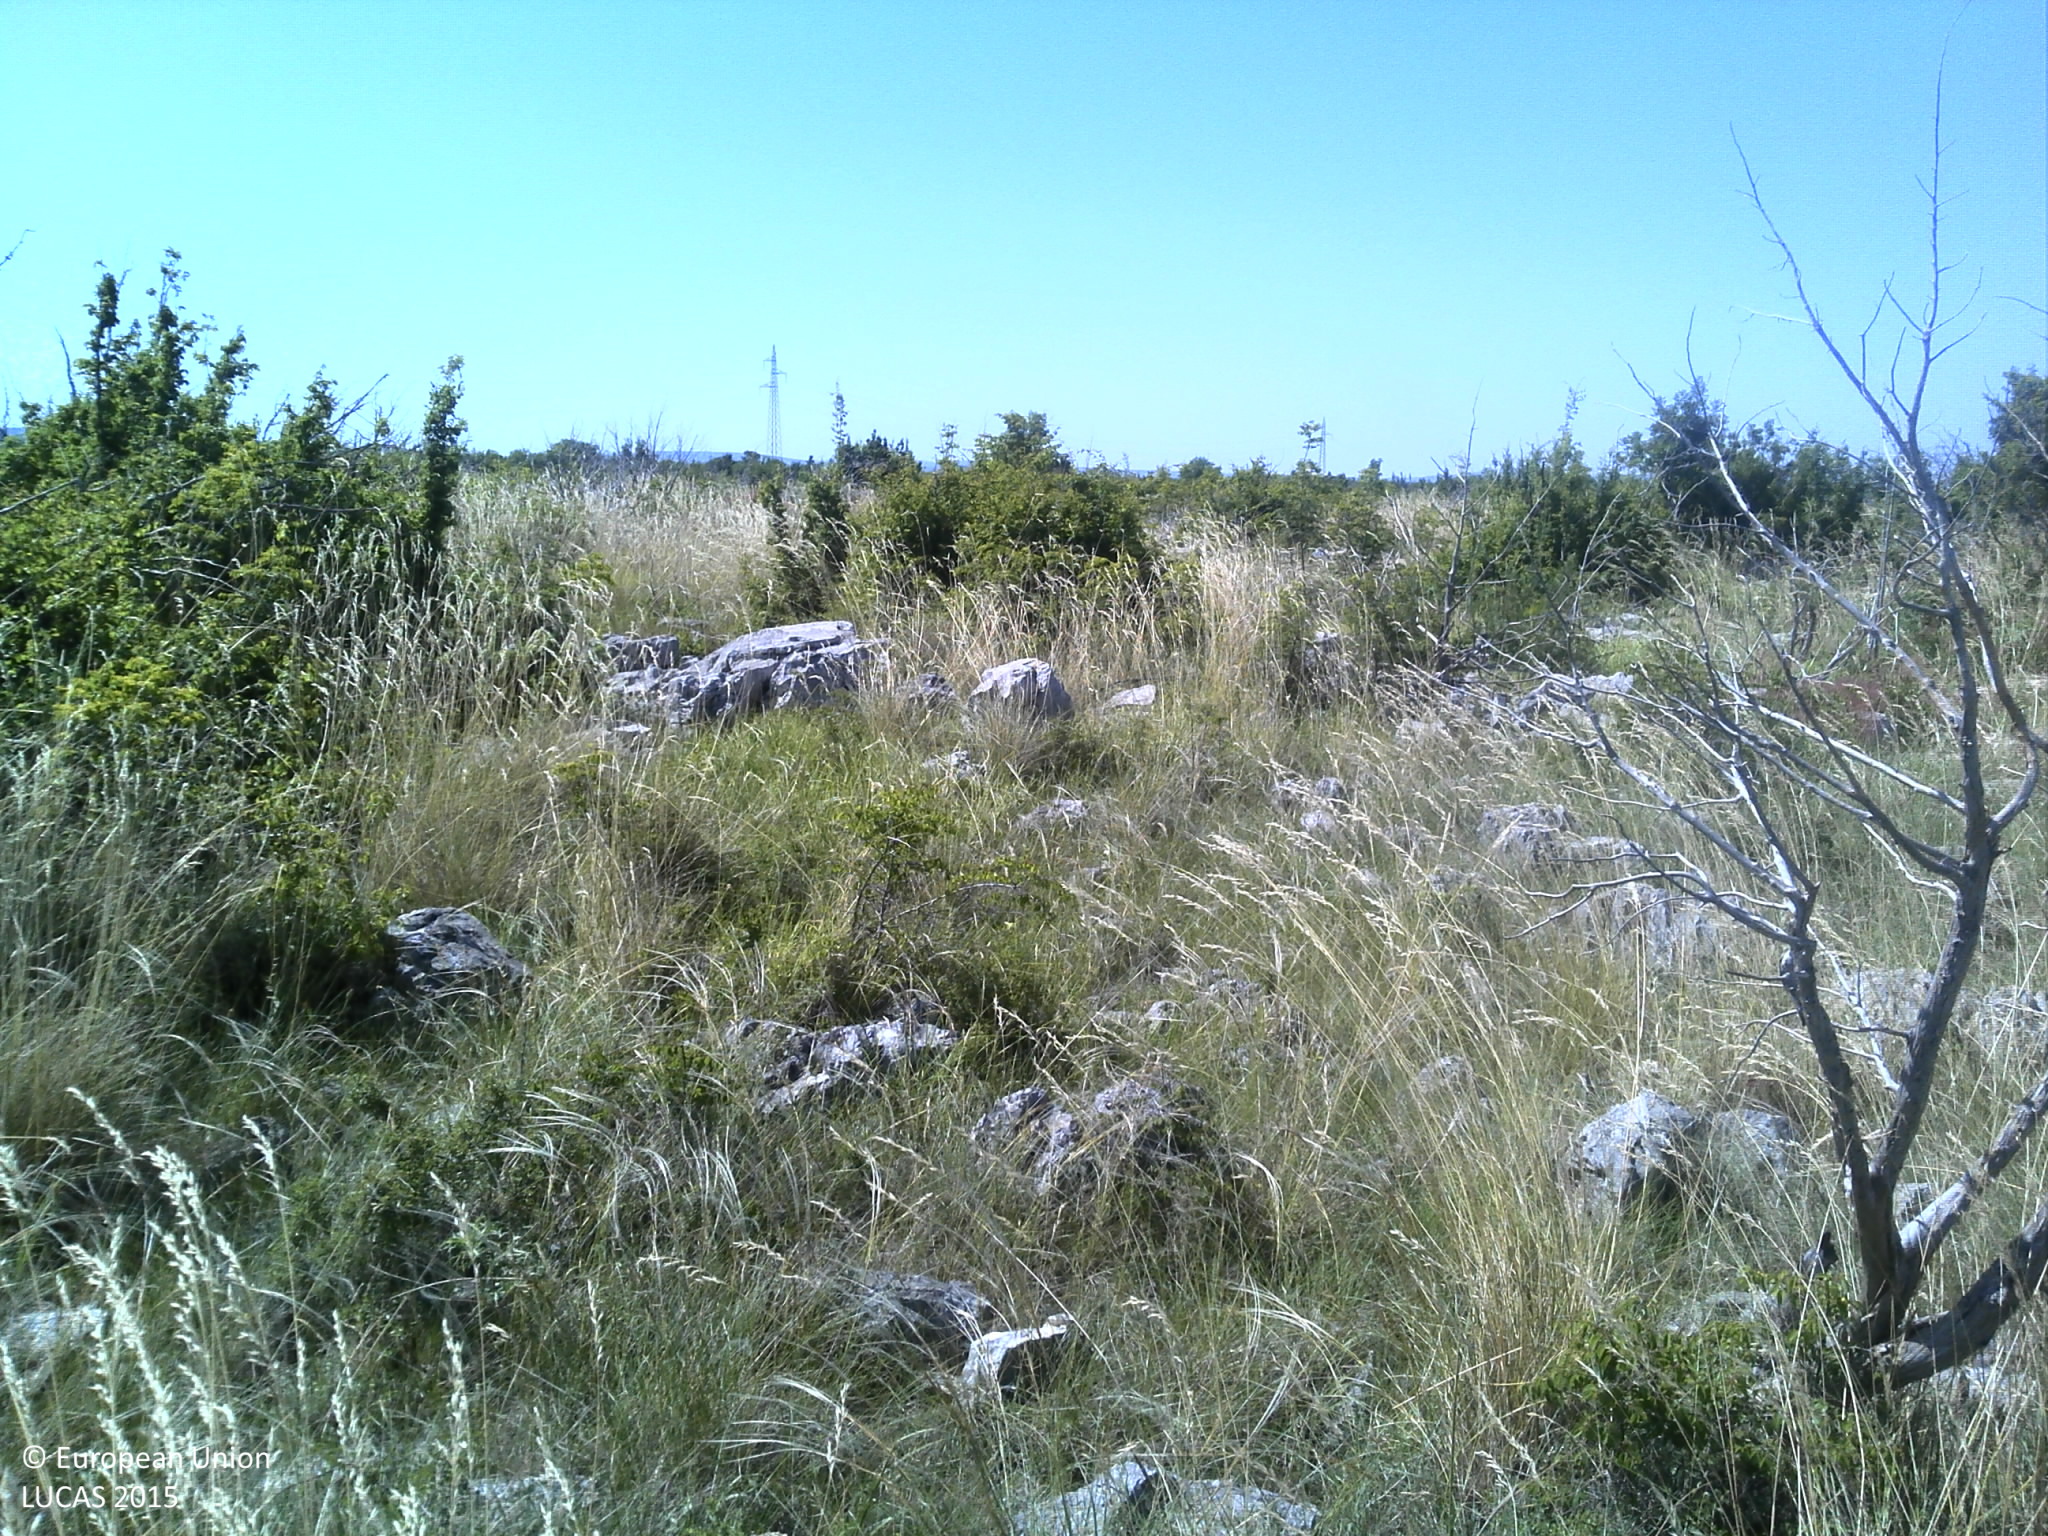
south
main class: Grassland
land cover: Grassland without tree/shrub cover
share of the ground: > 75 %
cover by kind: herbaceous plants 85 %, unconsolidated bare surface 10 %, shrubs 5 %
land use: Semi-natural and natural areas not in use
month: May
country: HR
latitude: 43.9549
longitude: 16.0857
